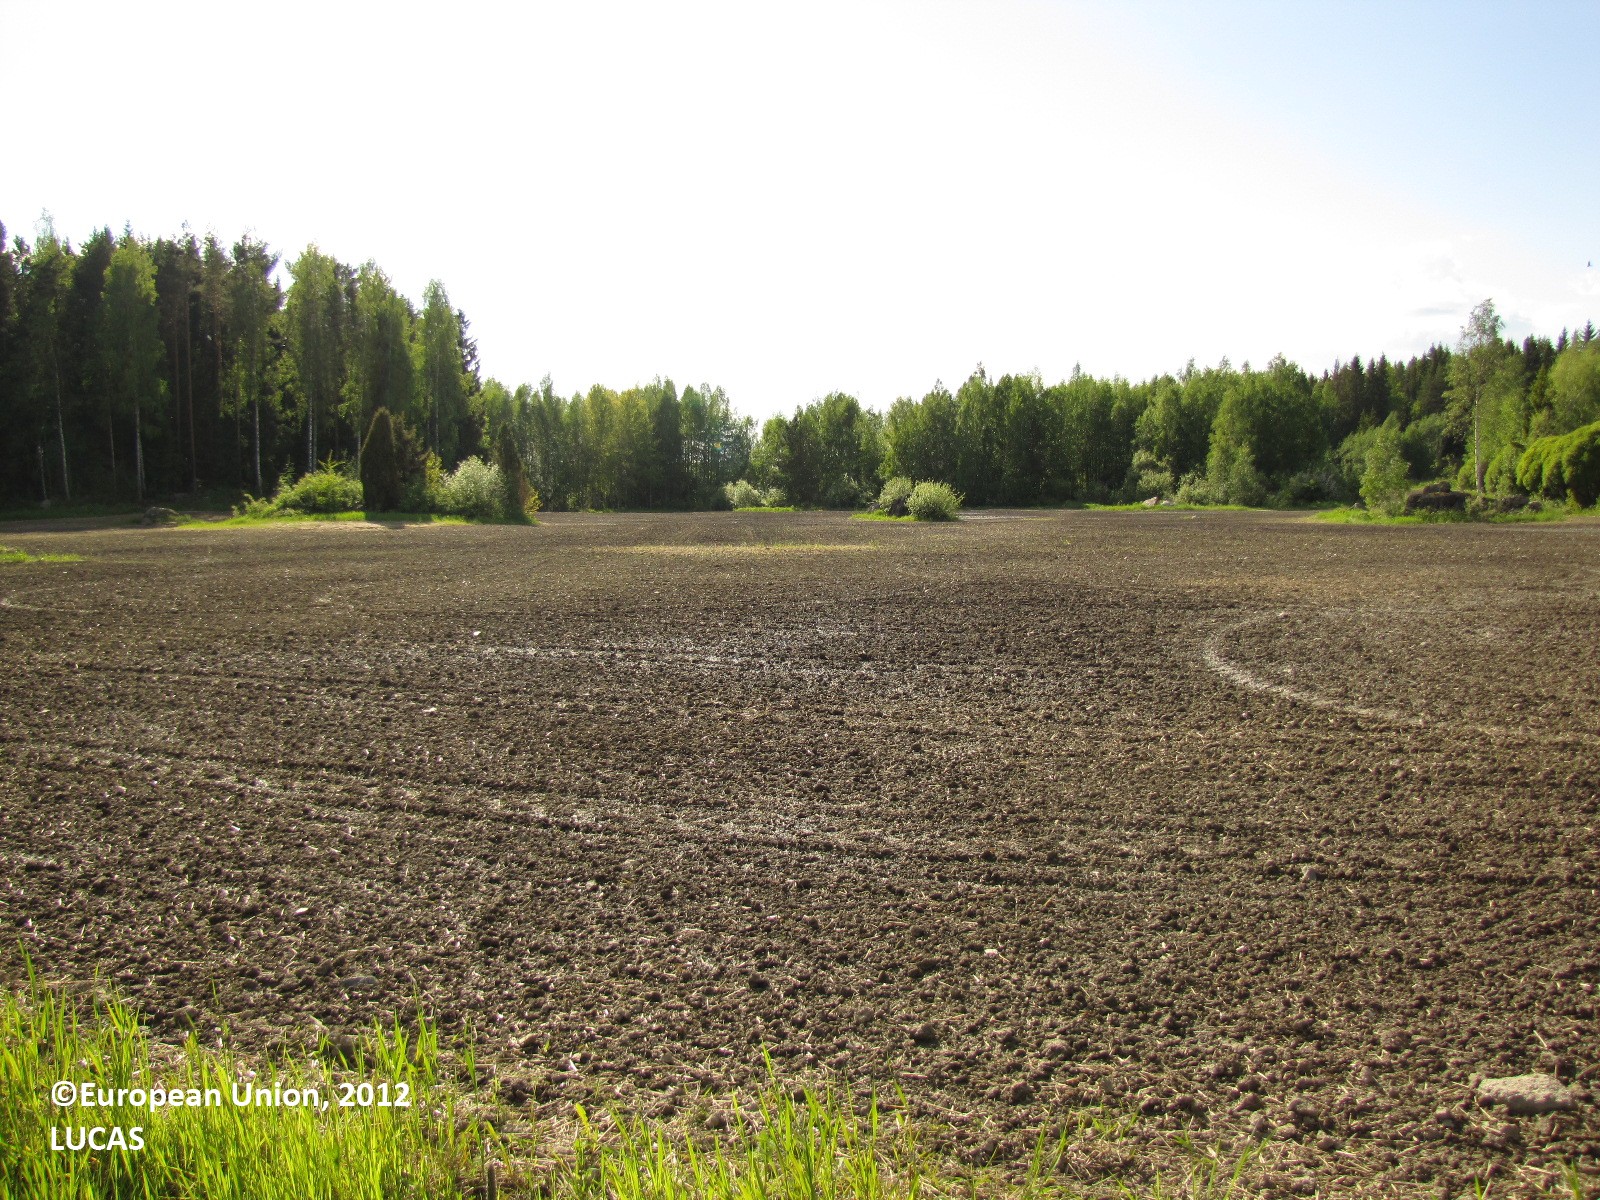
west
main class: Cropland
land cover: Barley
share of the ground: < 10 %
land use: Agriculture (excluding fallow land and kitchen gardens)
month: June
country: FI
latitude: 61.2625
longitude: 22.9556
